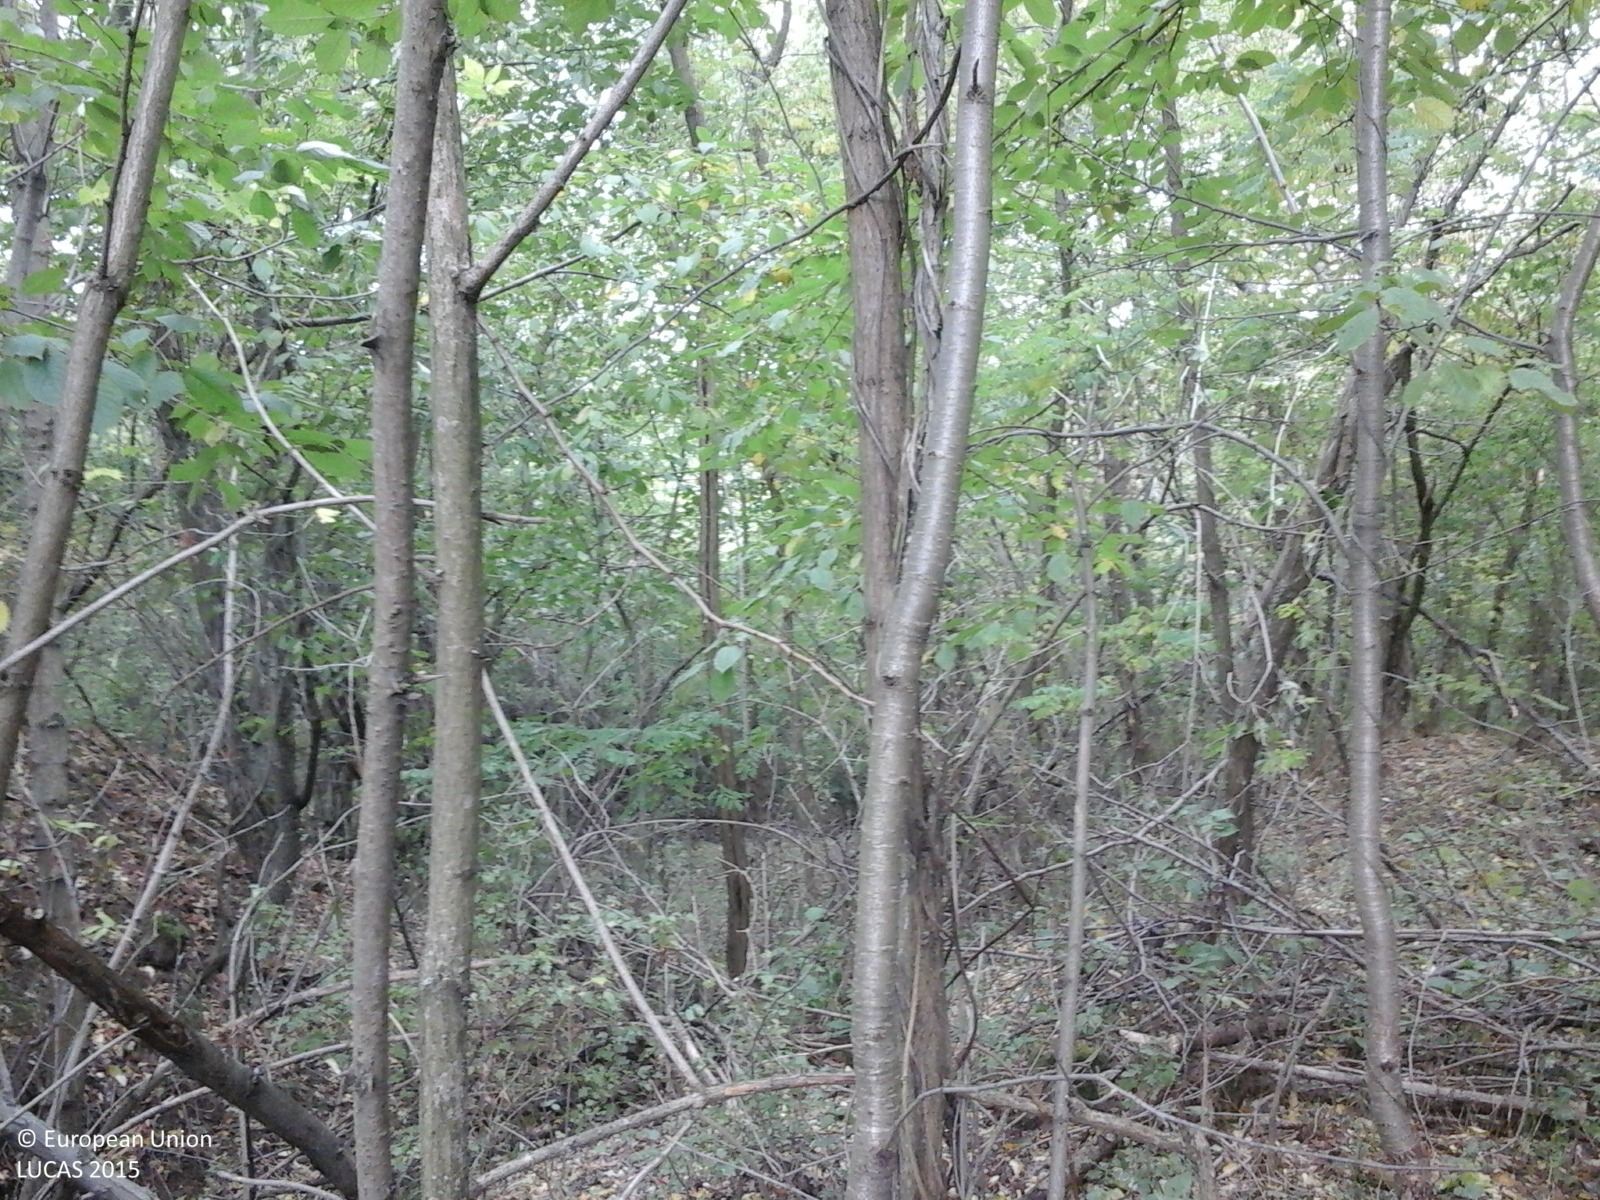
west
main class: Woodland
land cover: Broadleaved woodland
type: exotic forest
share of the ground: > 75 %
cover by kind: broadleaved forest trees 100 %
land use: Forestry
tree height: > 5 m
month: October
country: RO
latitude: 46.3917
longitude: 25.3323
